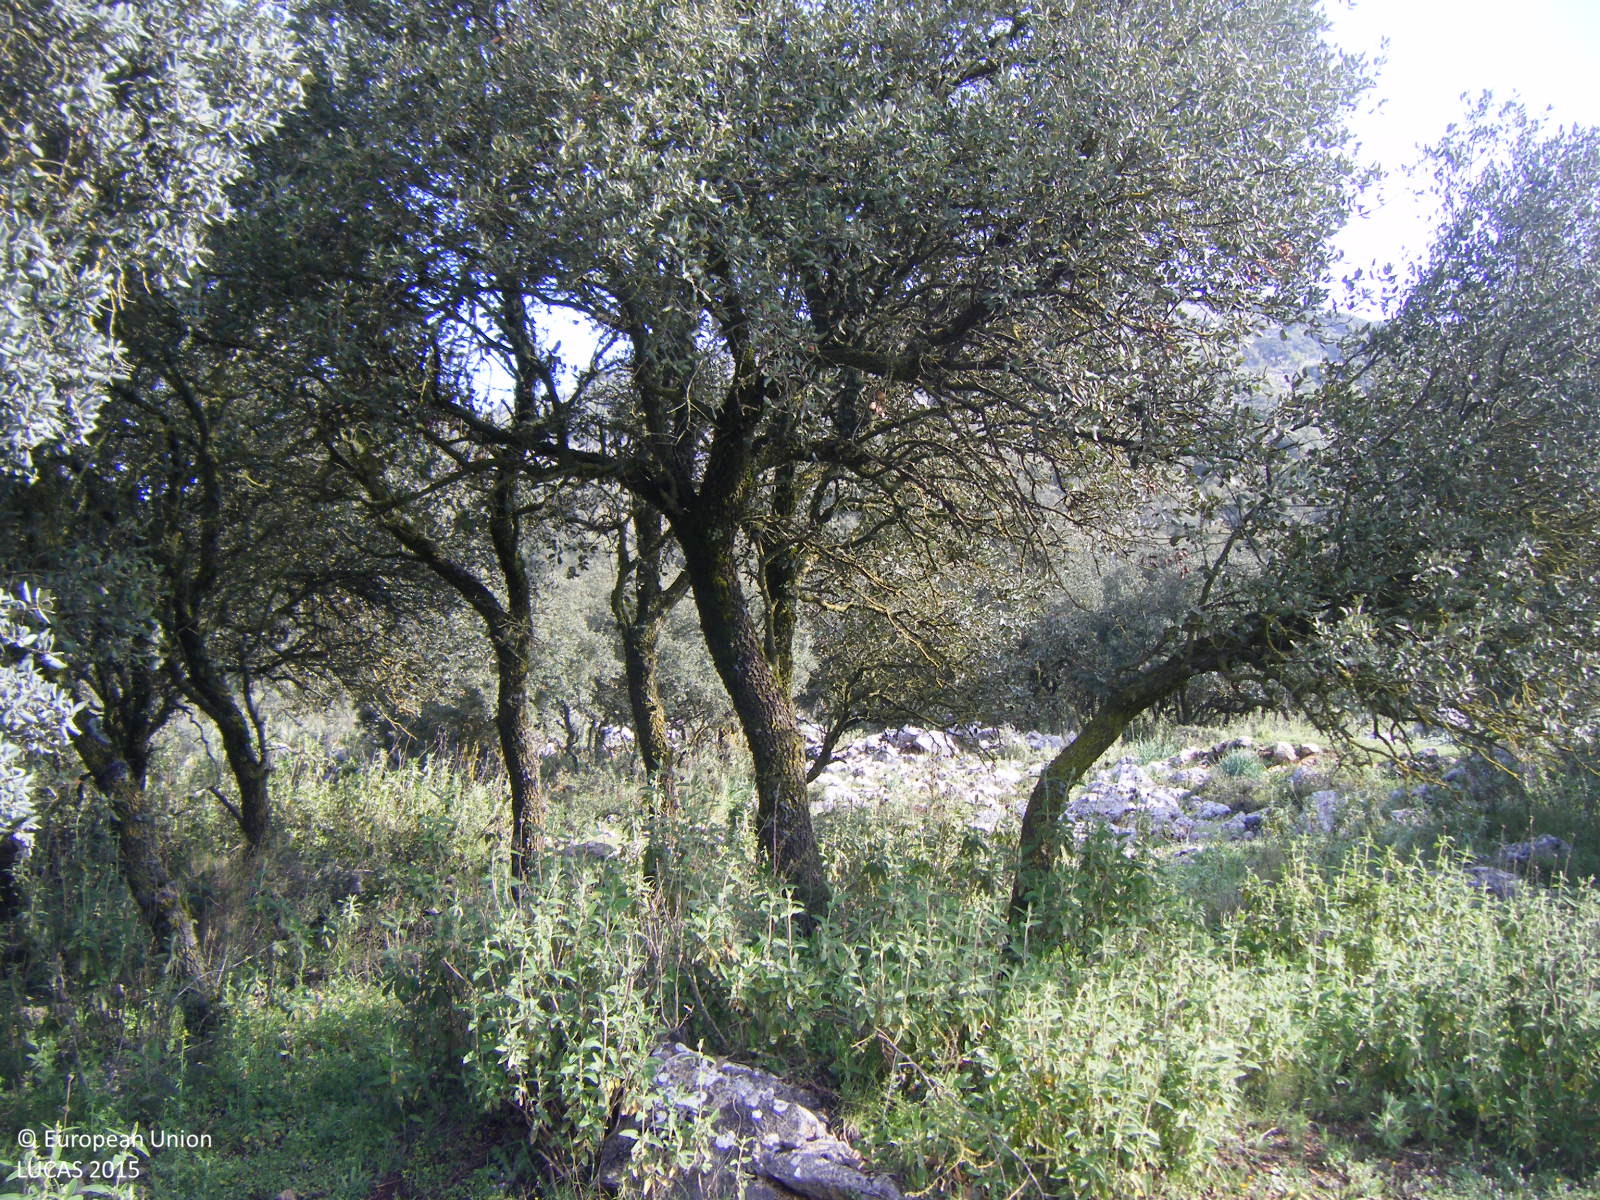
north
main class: Woodland
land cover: Broadleaved woodland
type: broadleaved evergreen forest
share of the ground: 10 - 25 %
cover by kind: herbaceous plants 50 %, broadleaved forest trees 25 %, shrubs 25 %
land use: Forestry
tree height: > 5 m
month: April
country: ES
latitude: 36.9689
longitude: -4.0873
